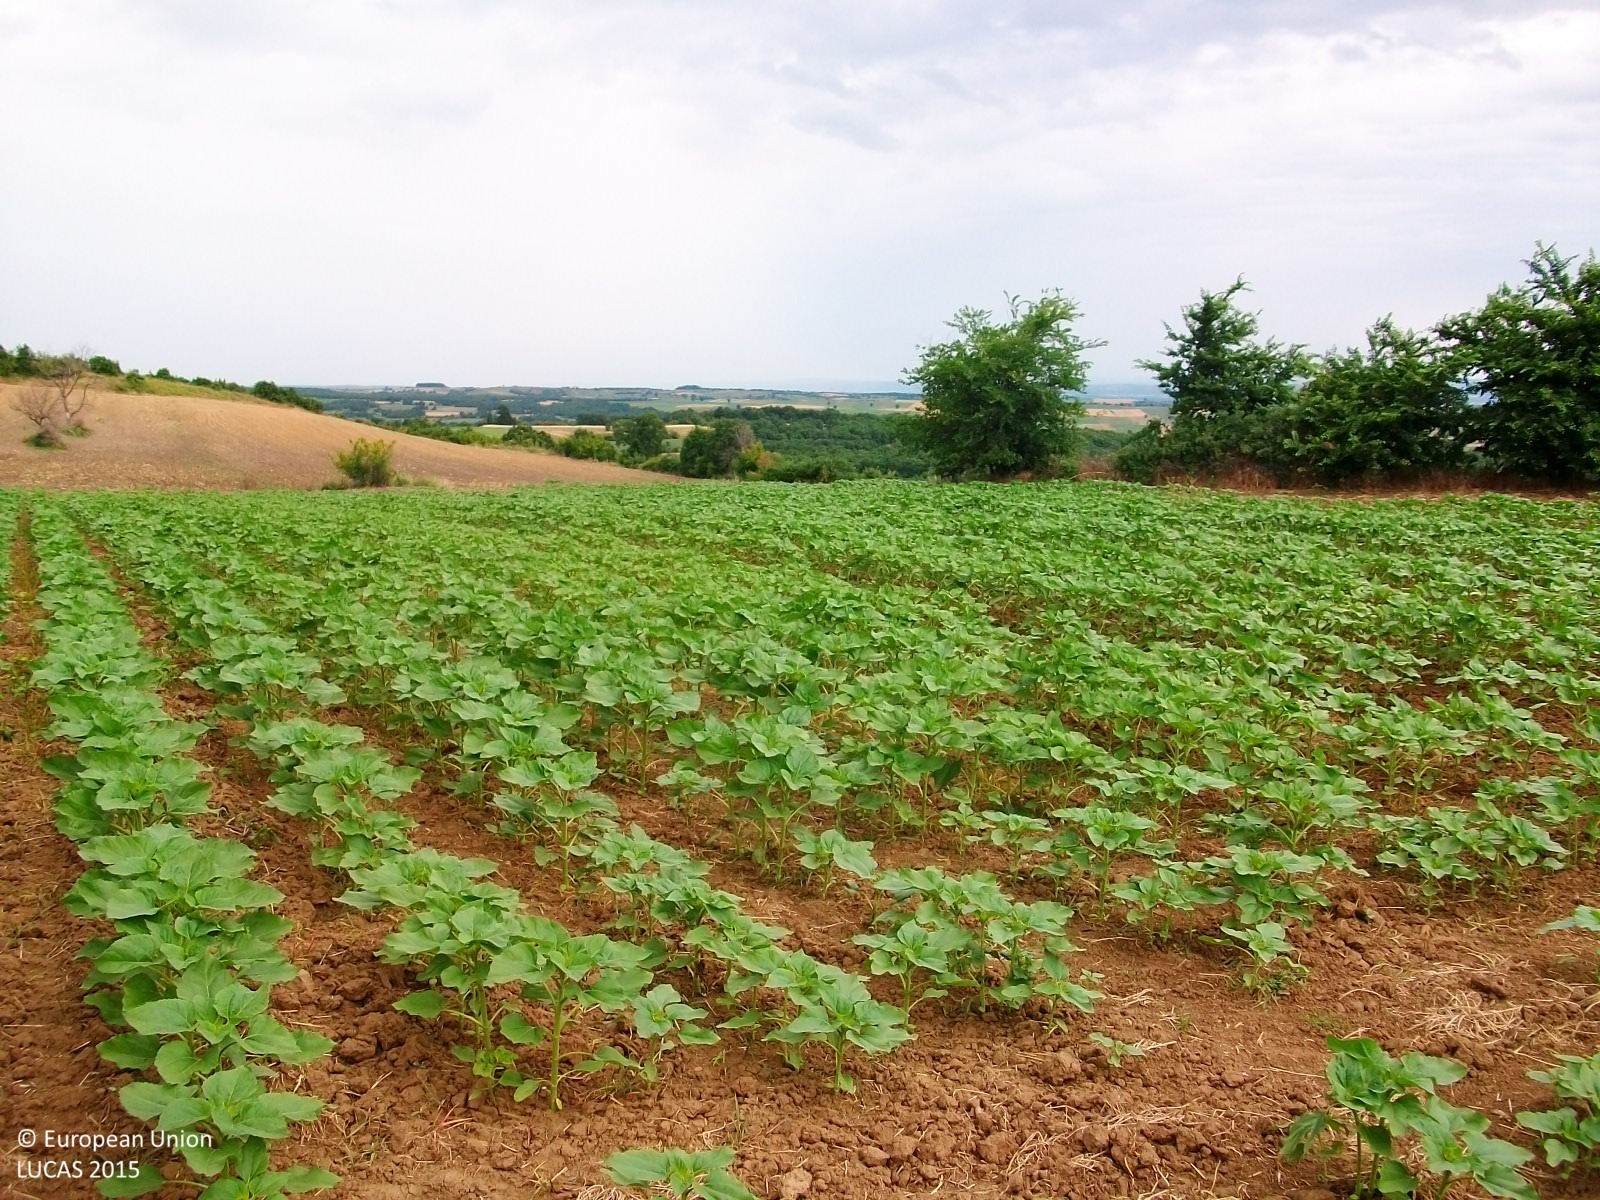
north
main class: Cropland
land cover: Sunflower
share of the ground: 10 - 25 %
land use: Agriculture (excluding fallow land and kitchen gardens)
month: June
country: GR
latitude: 41.6522
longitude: 26.2004
